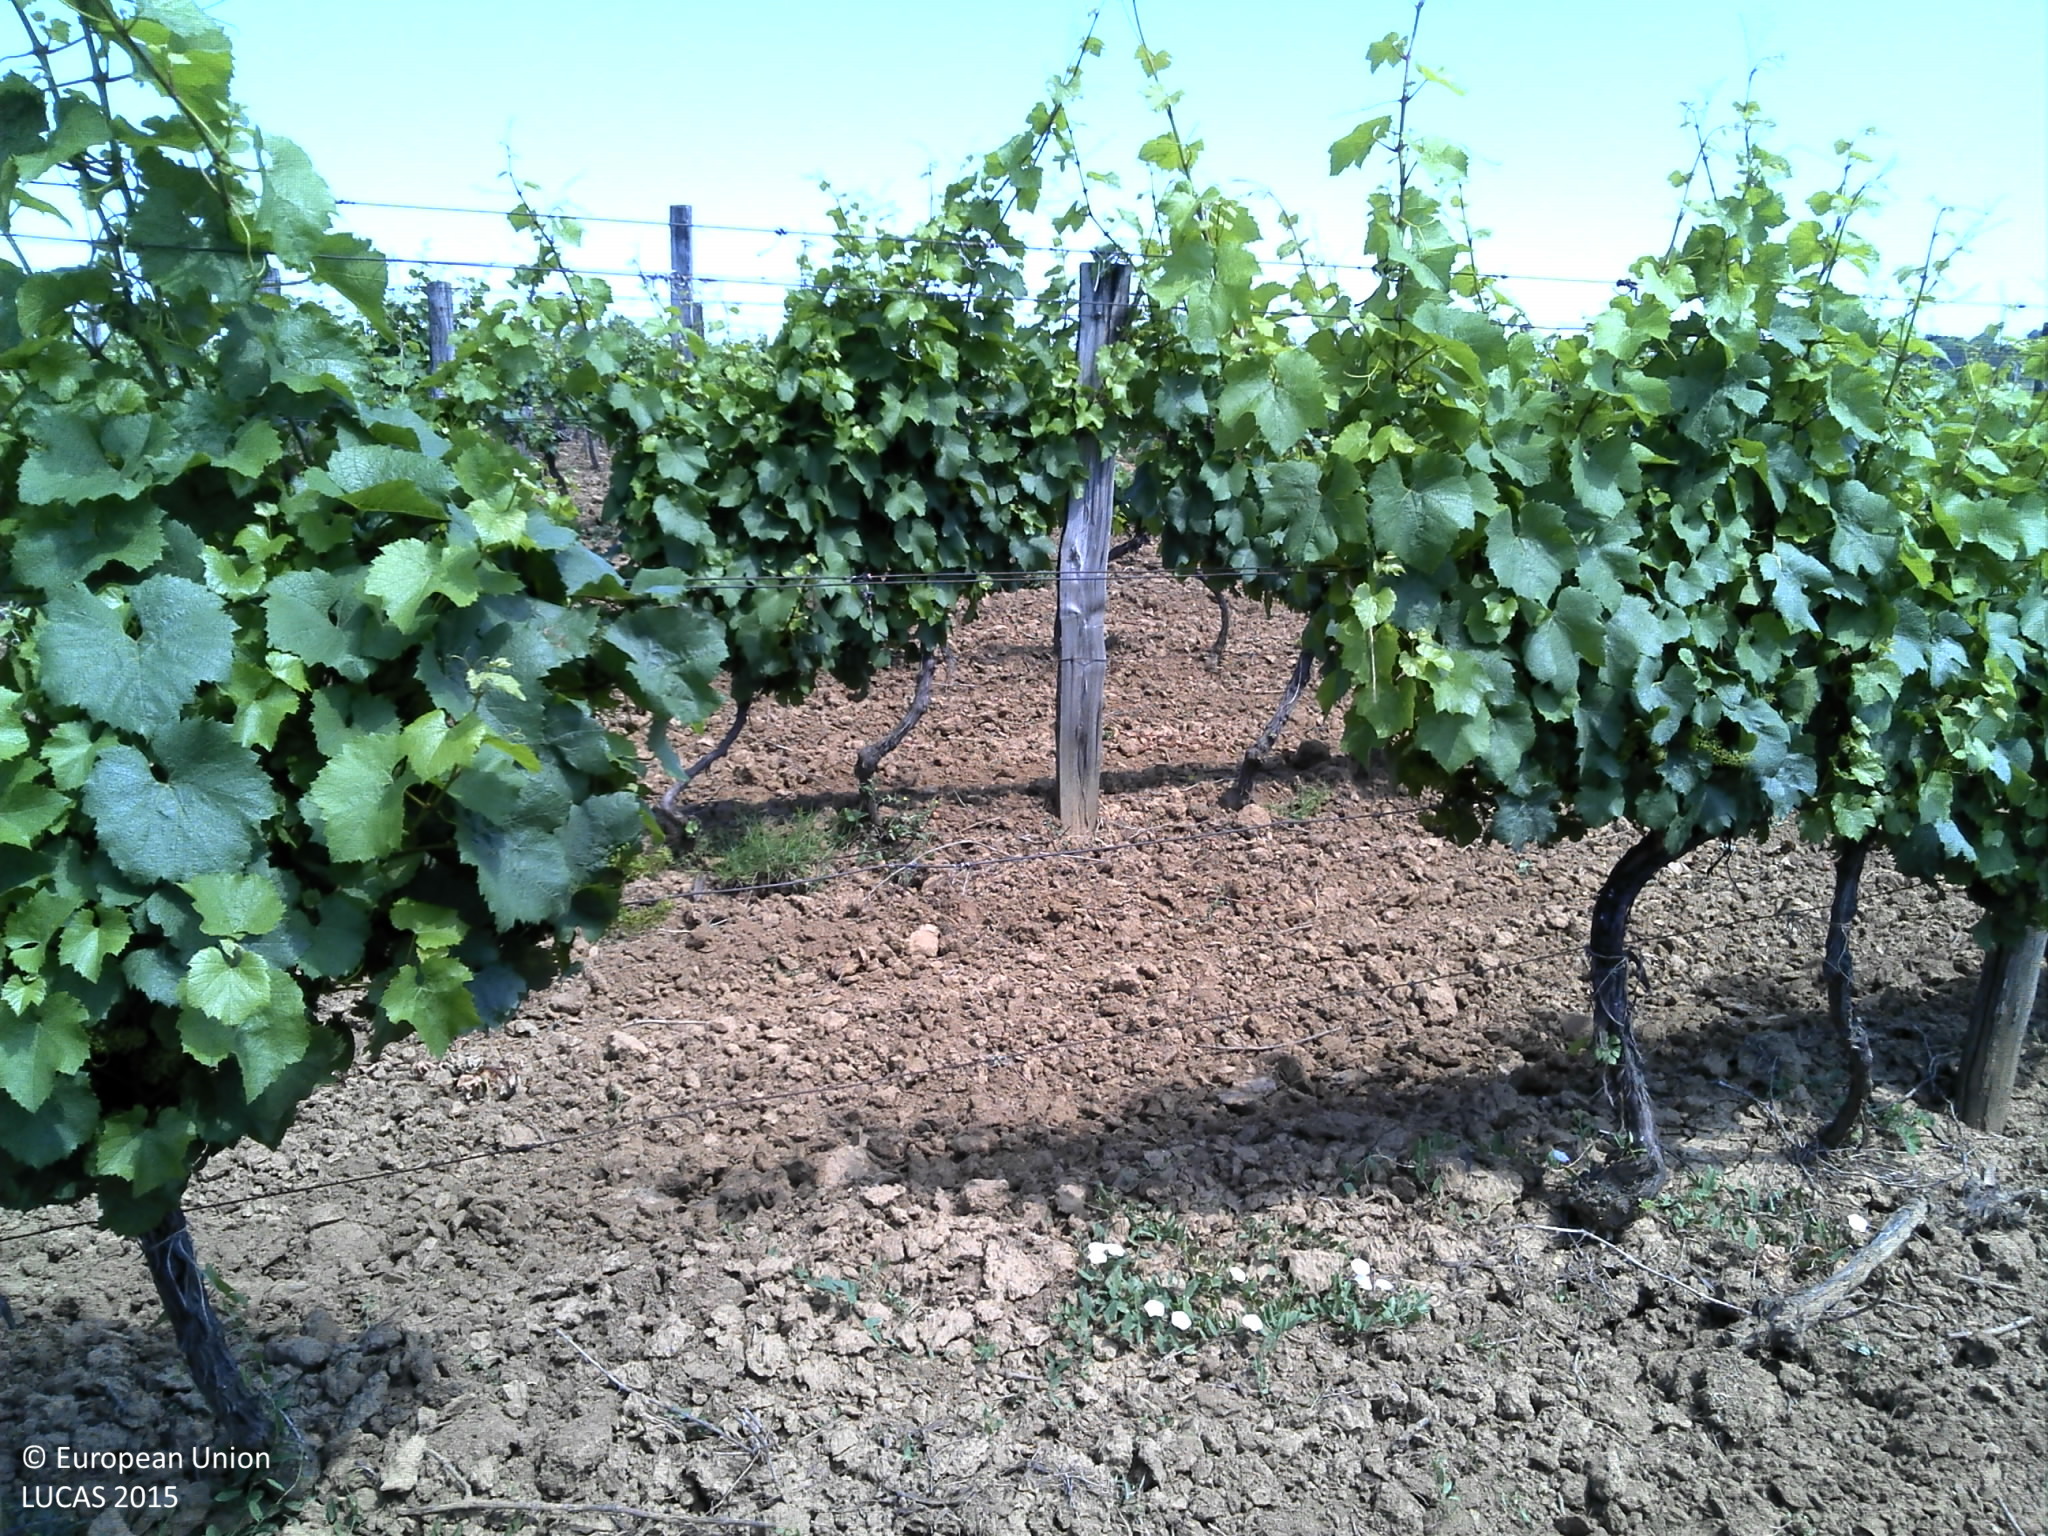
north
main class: Cropland
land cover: Vineyards
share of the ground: 25 - 50 %
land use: Agriculture (excluding fallow land and kitchen gardens)
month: June
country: HR
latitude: 45.7796
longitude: 18.6902
